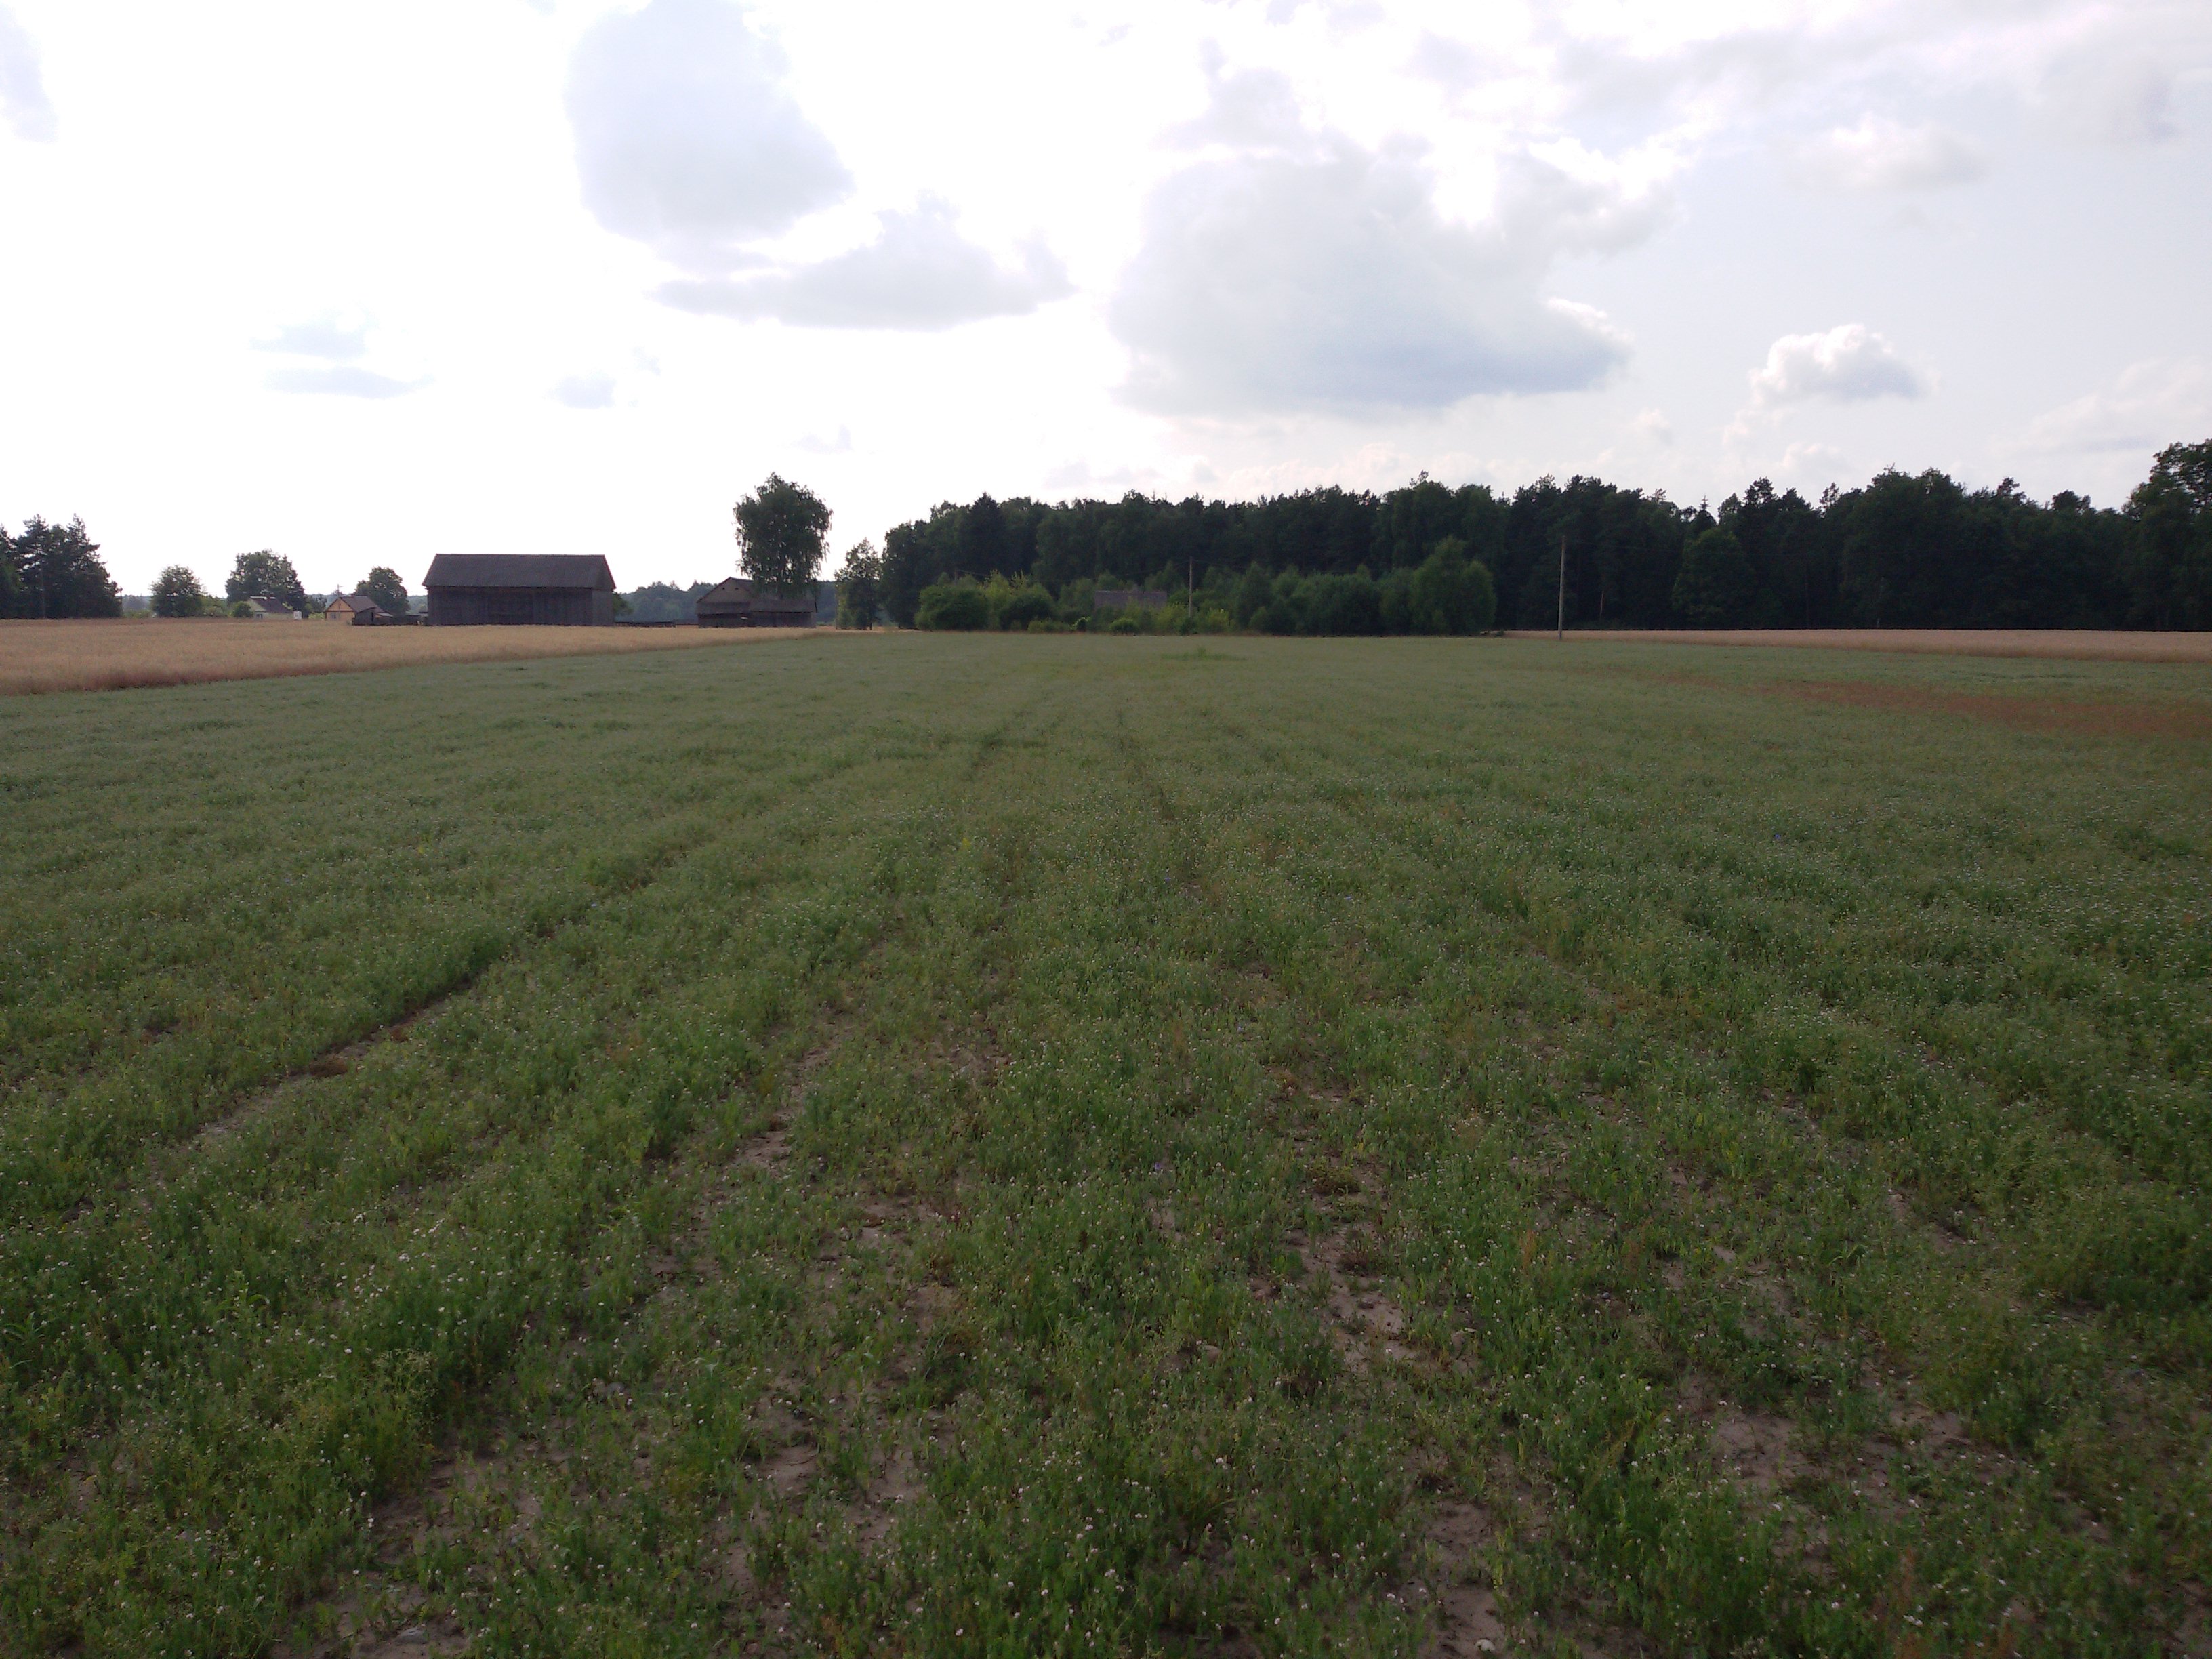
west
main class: Cropland
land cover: Dry pulses
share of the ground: > 75 %
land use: Agriculture (excluding fallow land and kitchen gardens)
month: July
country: PL
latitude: 51.9587
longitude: 22.9235
